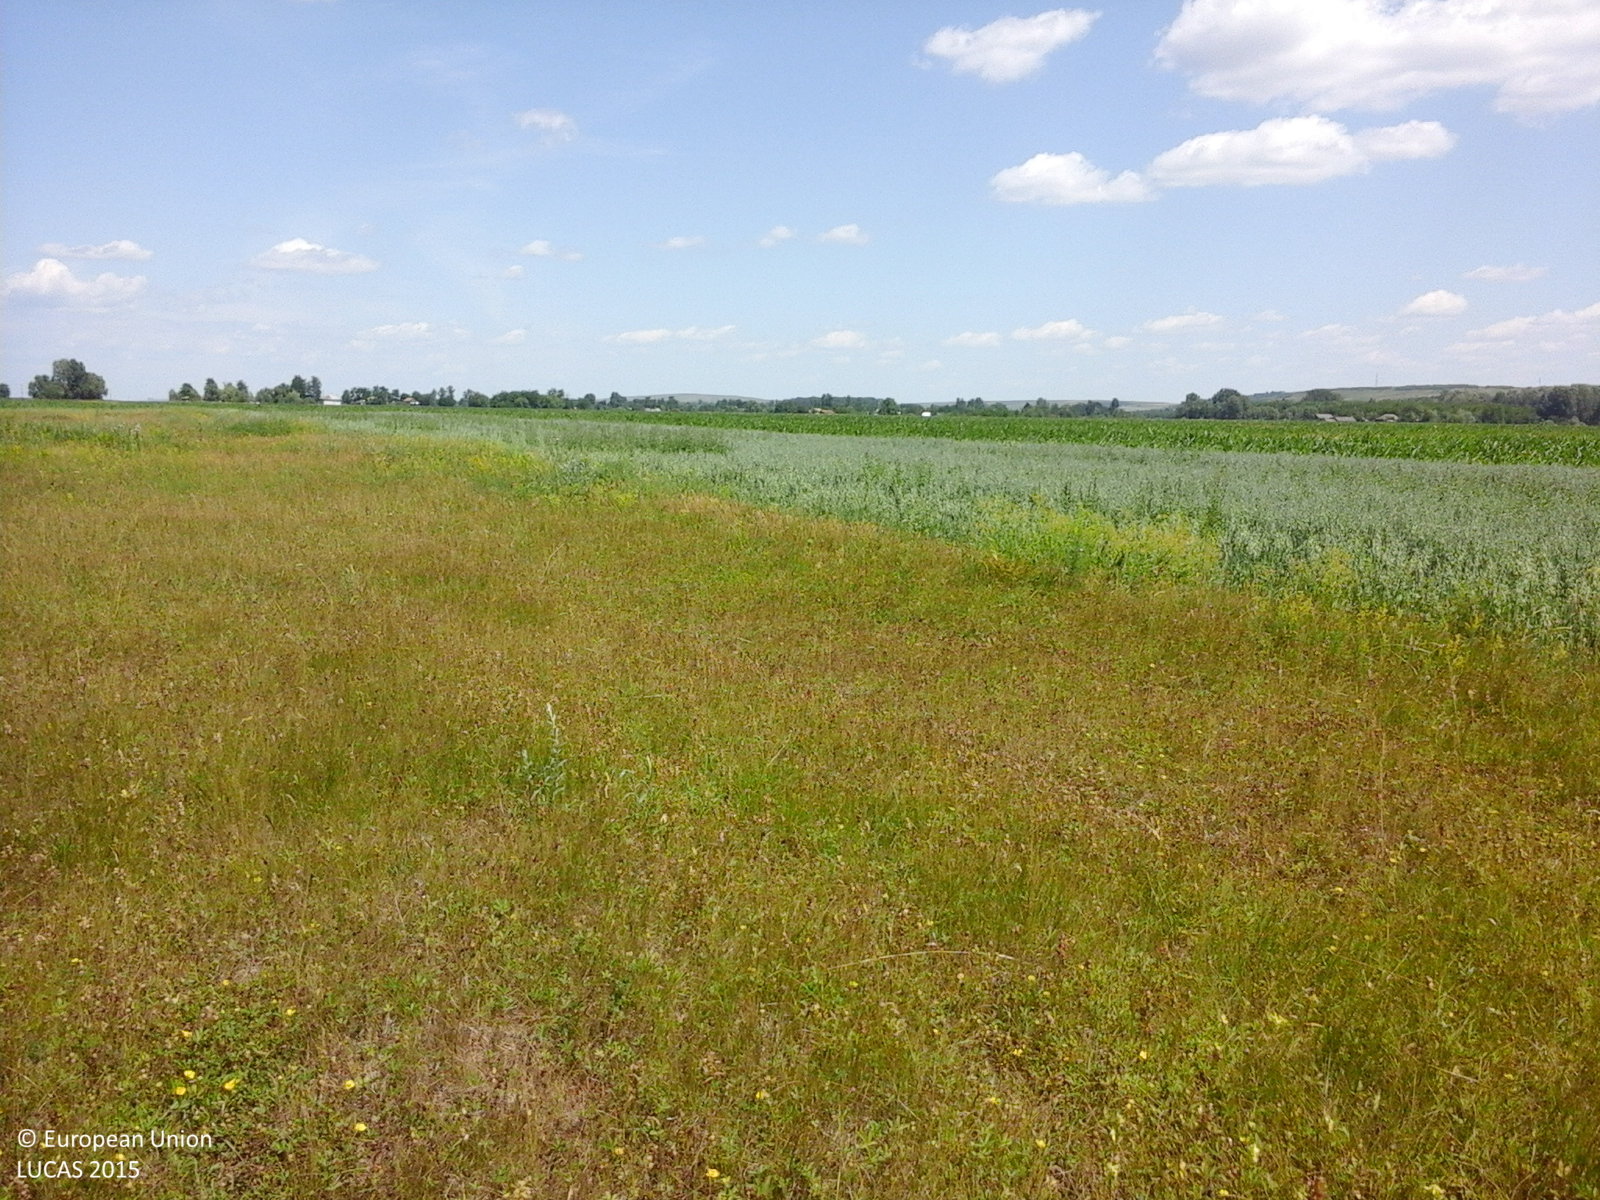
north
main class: Grassland
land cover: Grassland without tree/shrub cover
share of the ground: > 75 %
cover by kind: herbaceous plants 100 %
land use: Agriculture (excluding fallow land and kitchen gardens)
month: June
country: RO
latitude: 47.5482
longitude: 26.5537
